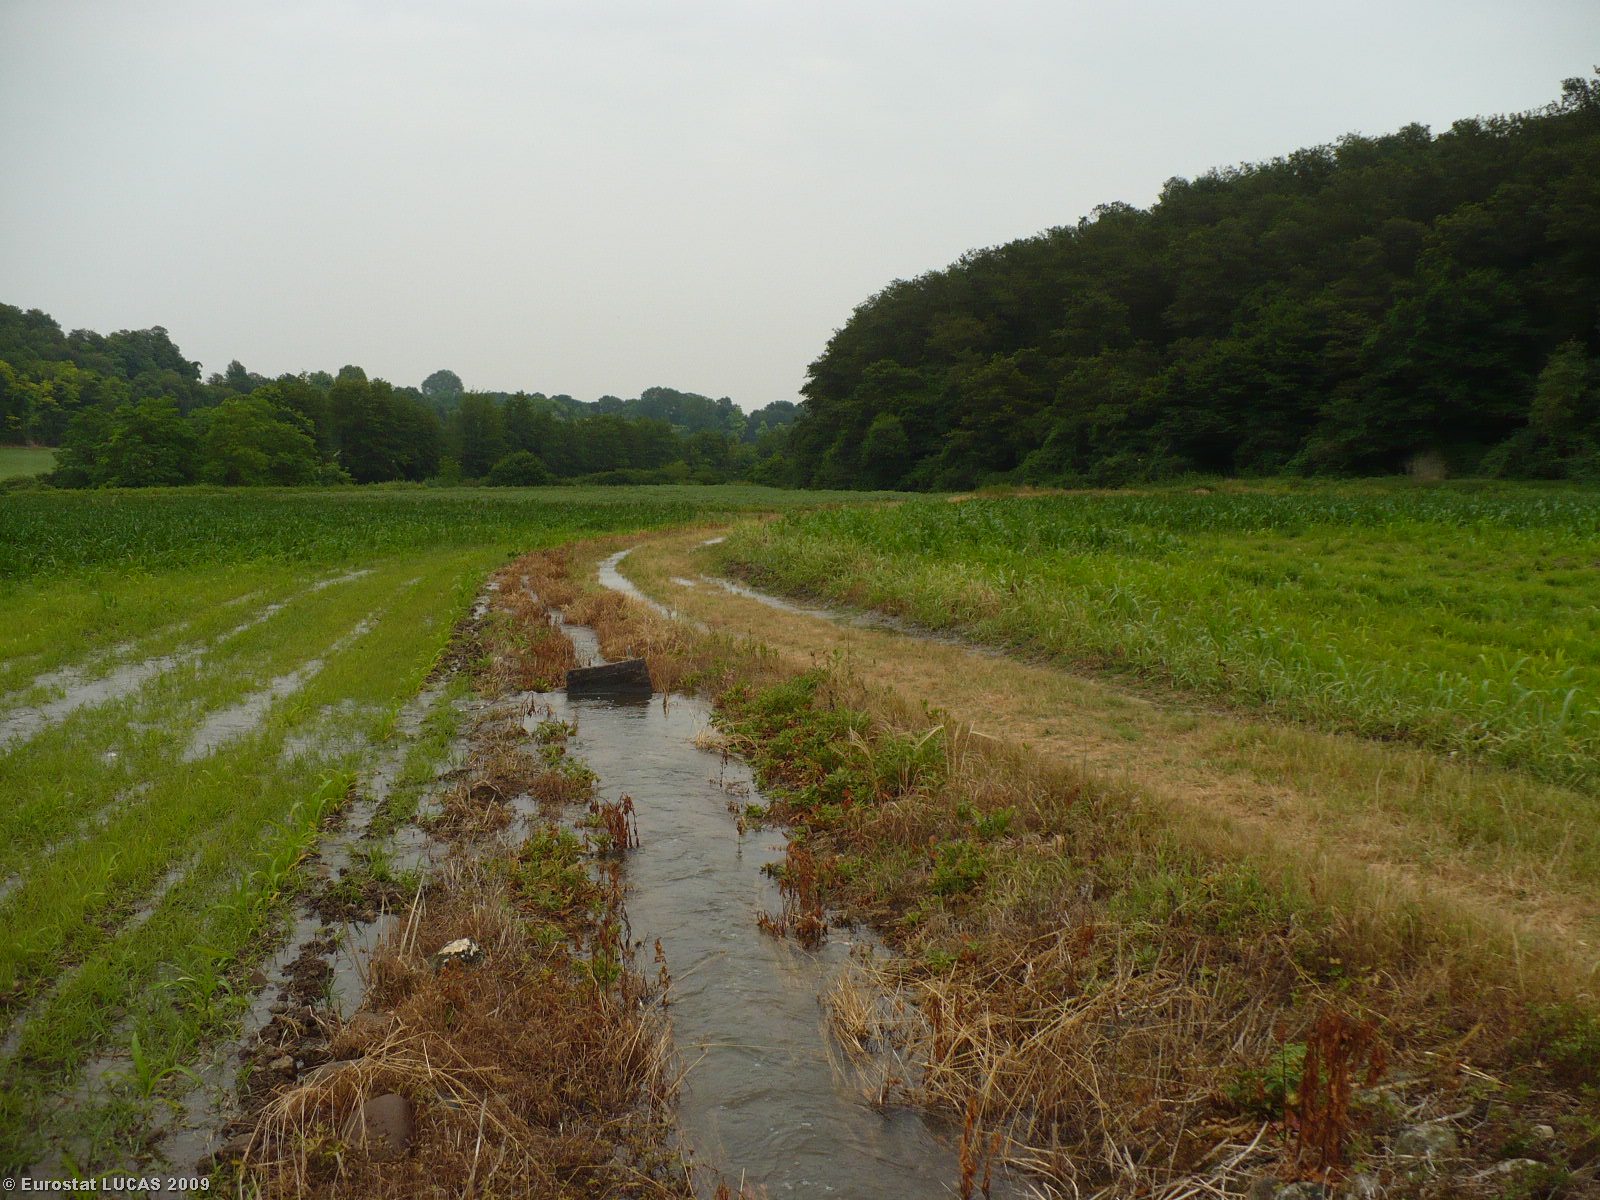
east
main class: Cropland
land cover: Maize
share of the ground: 50 - 75 %
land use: Agriculture (excluding fallow land and kitchen gardens)
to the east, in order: Maize; Artificial constructions in urban areas; Spontaneously vegetated surfaces; Ditches and canals; Single bushes/trees; Grassland without tree/shrub cover
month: June
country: IT
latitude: 45.3934
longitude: 10.7778
